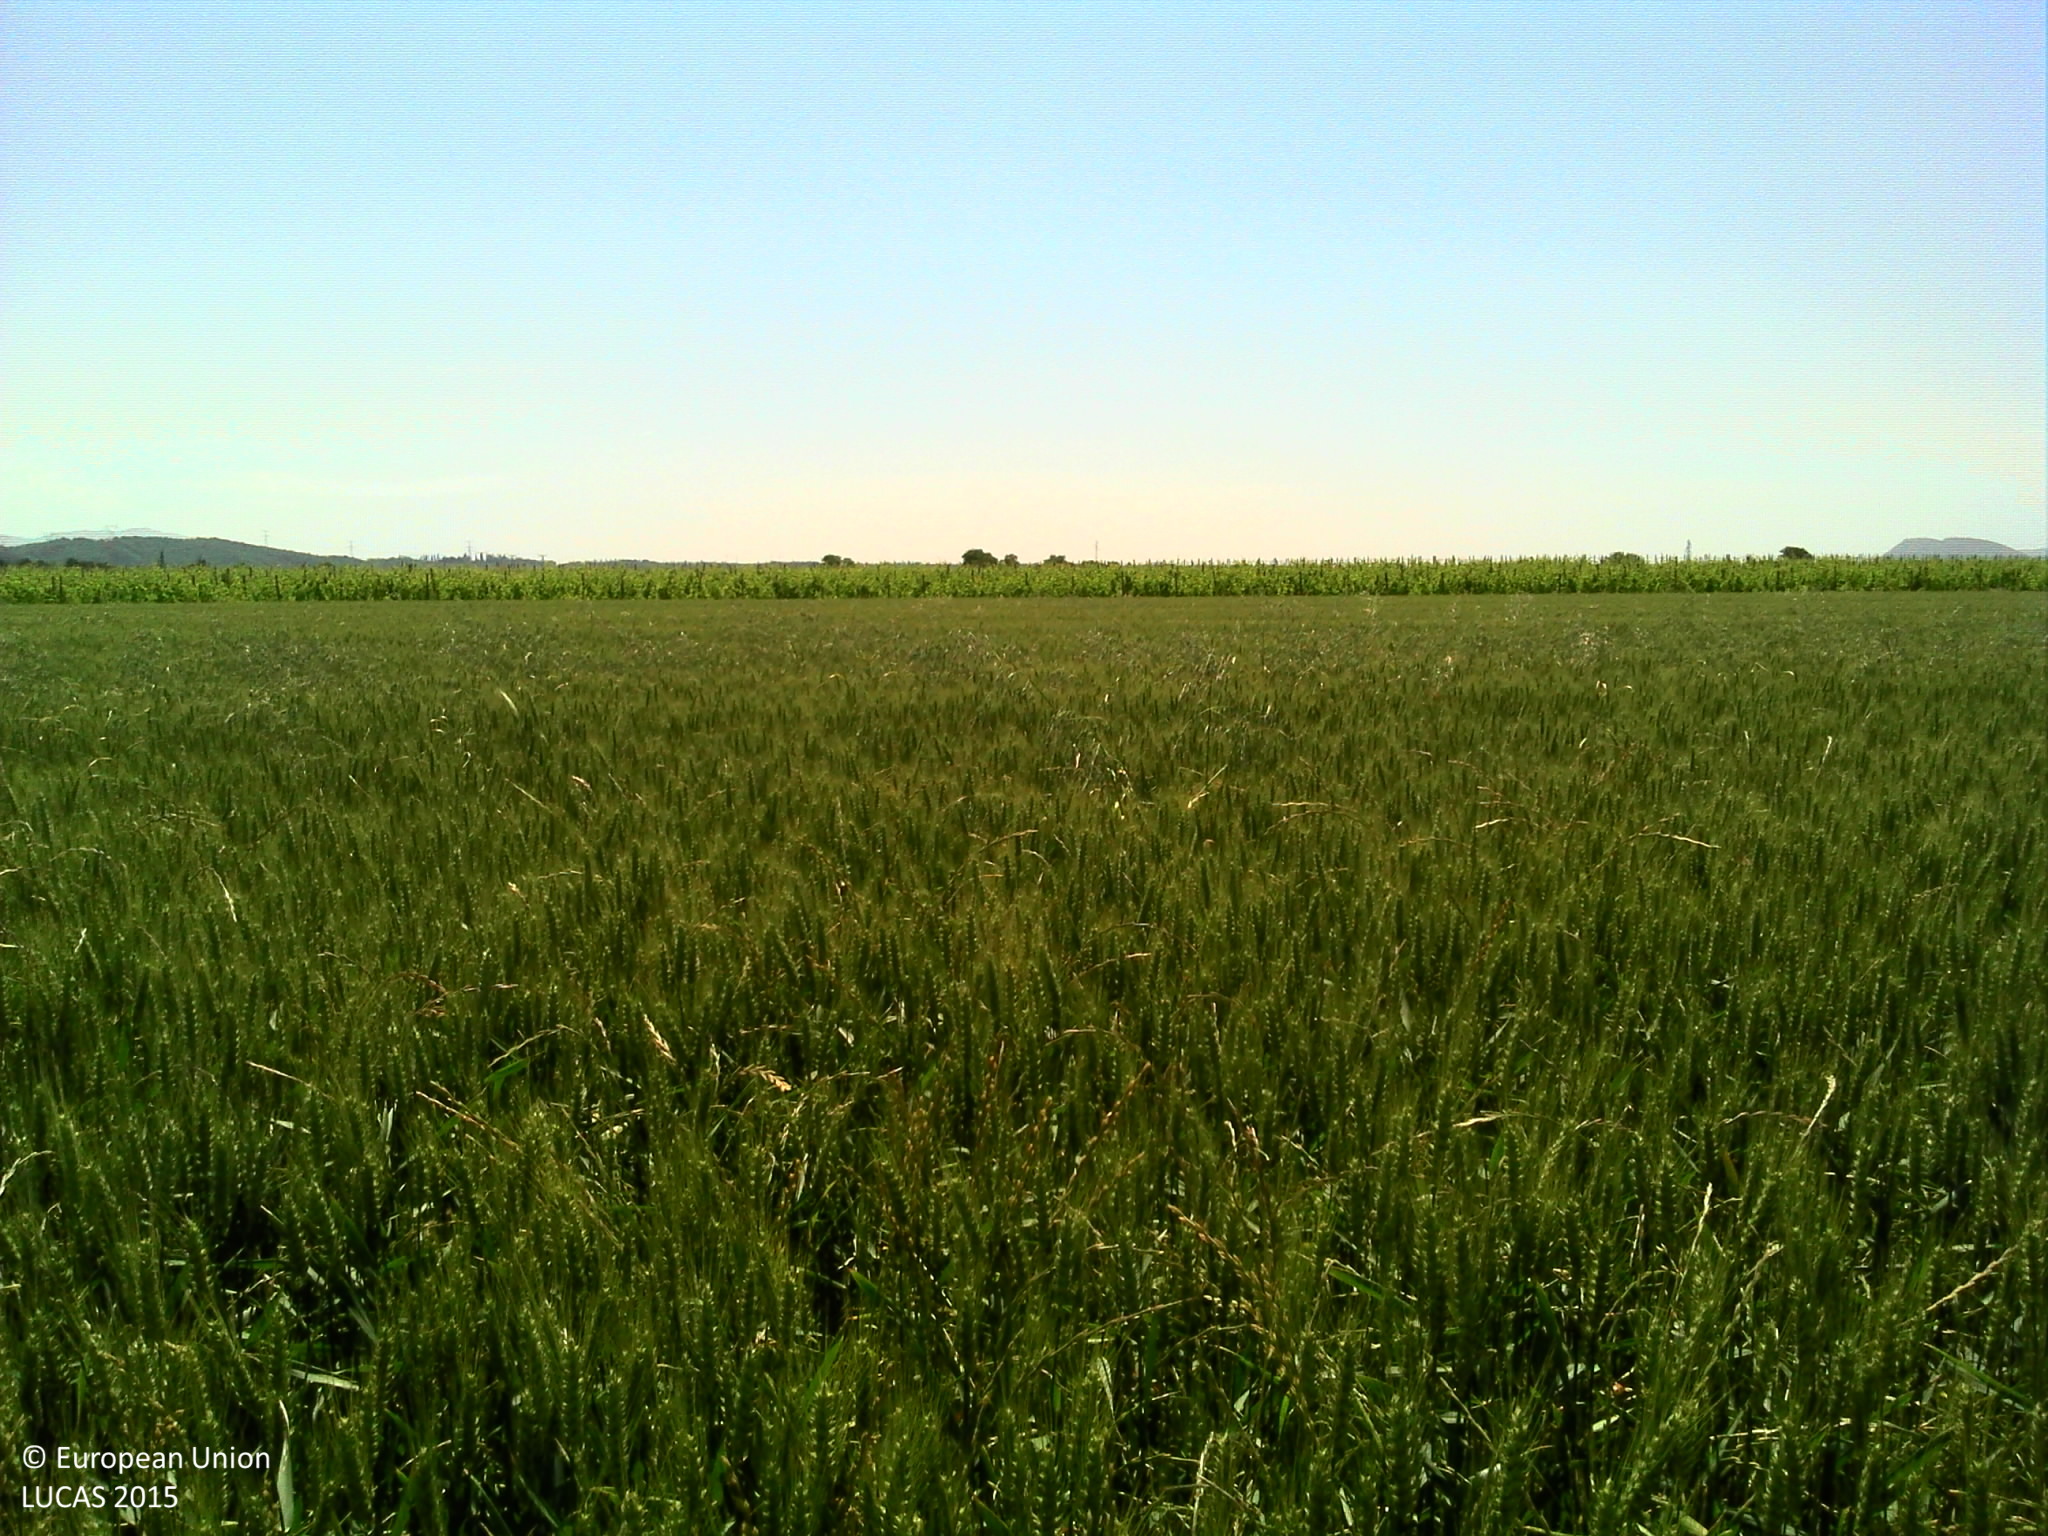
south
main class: Cropland
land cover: Common wheat
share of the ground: > 75 %
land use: Agriculture (excluding fallow land and kitchen gardens)
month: May
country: FR
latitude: 45.0388
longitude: 4.9150
